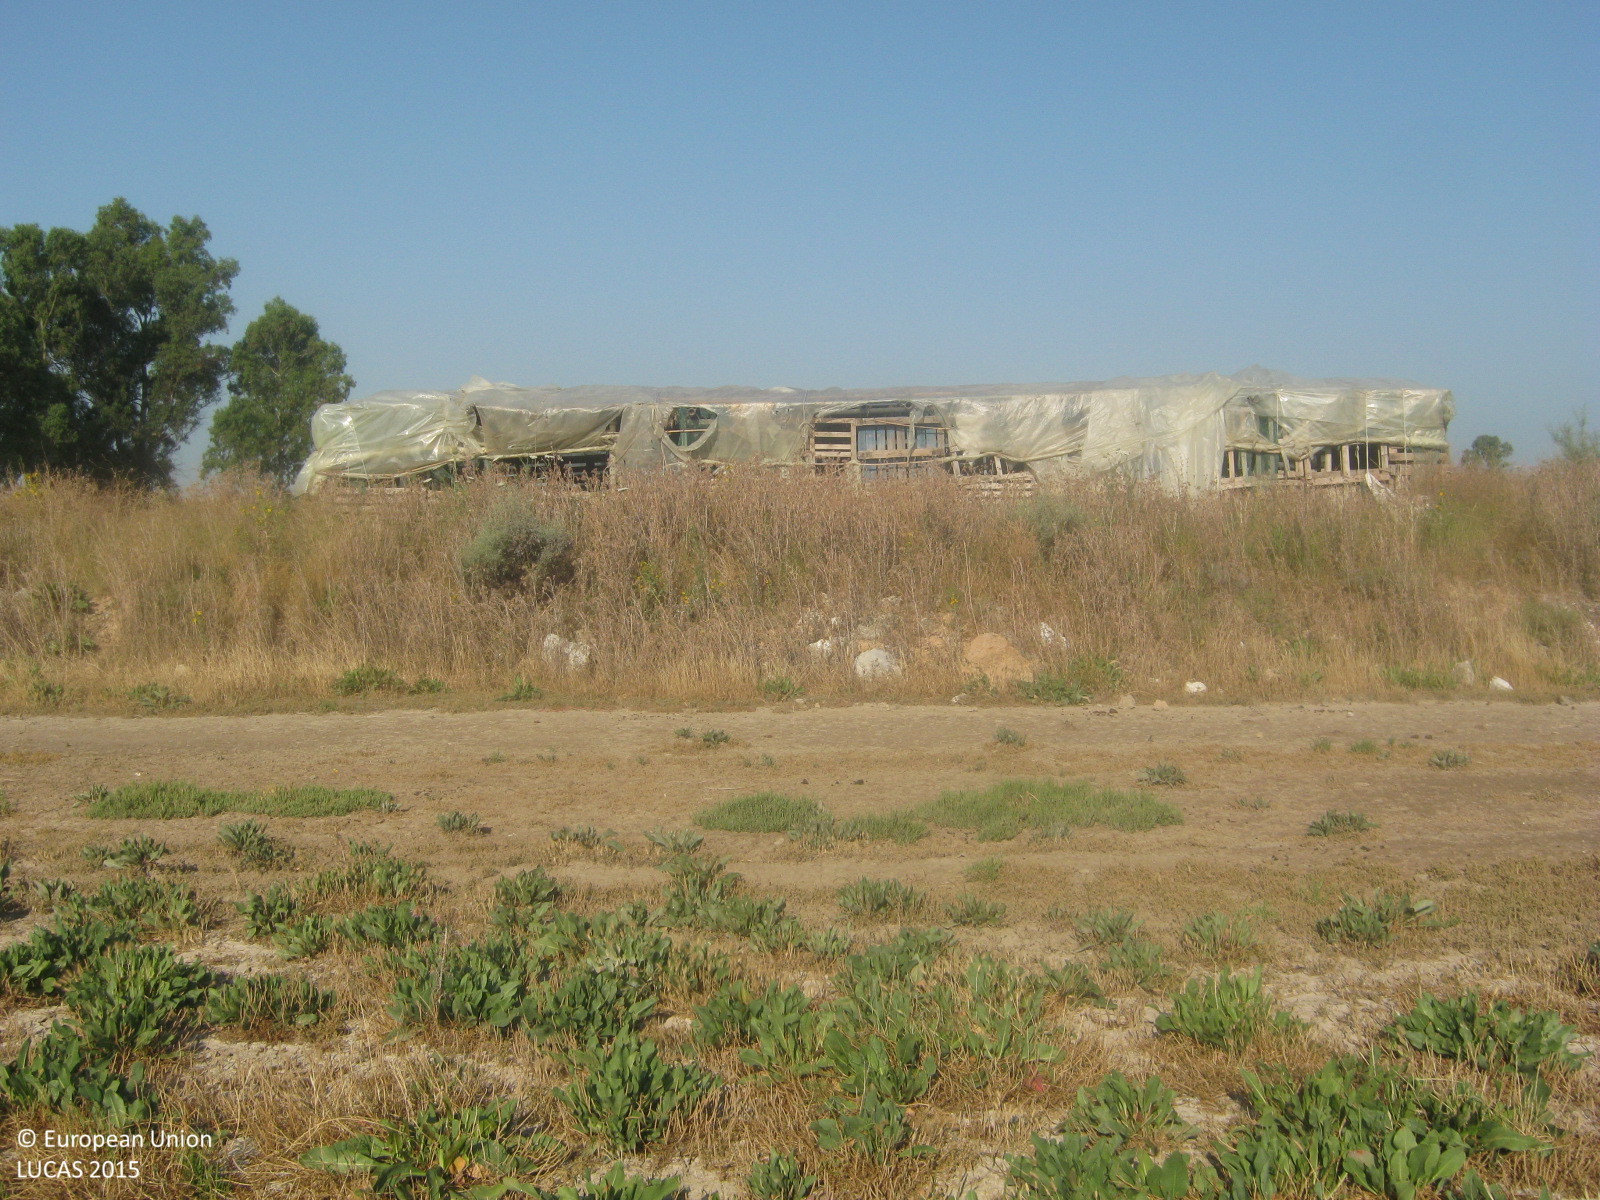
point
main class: Grassland
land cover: Spontaneously vegetated surfaces
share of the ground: 50 - 75 %
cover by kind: herbaceous plants 60 %, unconsolidated bare surface 35 %, shrubs 5 %
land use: Semi-natural and natural areas not in use
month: June
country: GR
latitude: 38.3897
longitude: 21.2896
